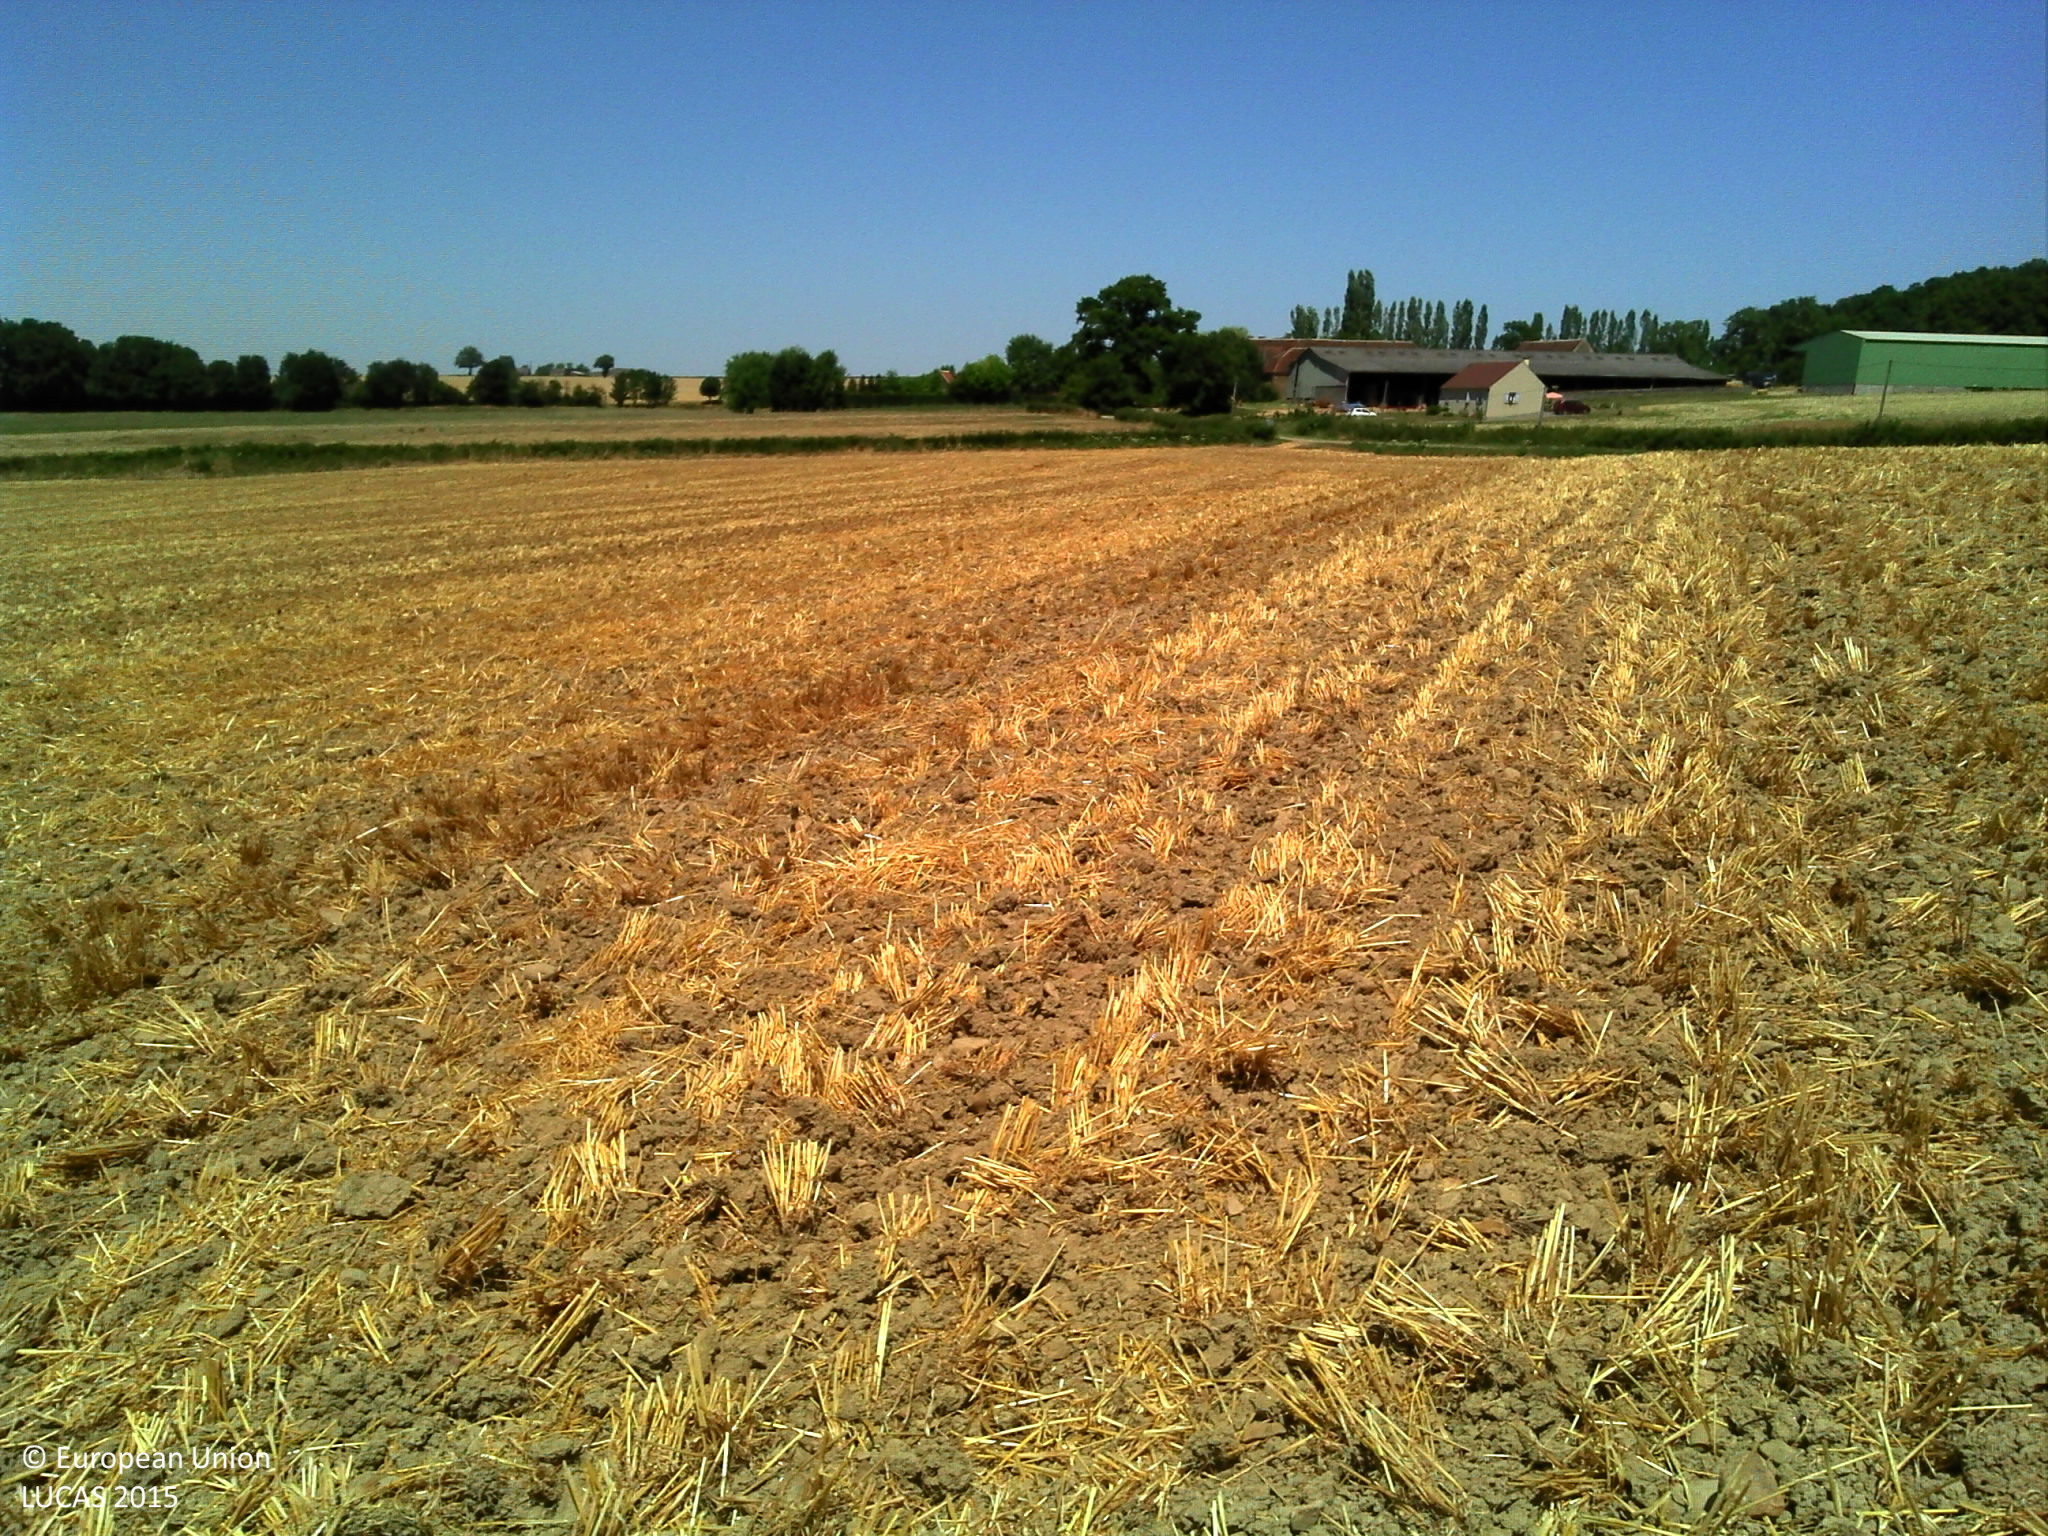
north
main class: Cropland
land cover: Barley
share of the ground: > 75 %
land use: Agriculture (excluding fallow land and kitchen gardens)
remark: Harvested field
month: July
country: FR
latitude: 46.9152
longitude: 3.5508
